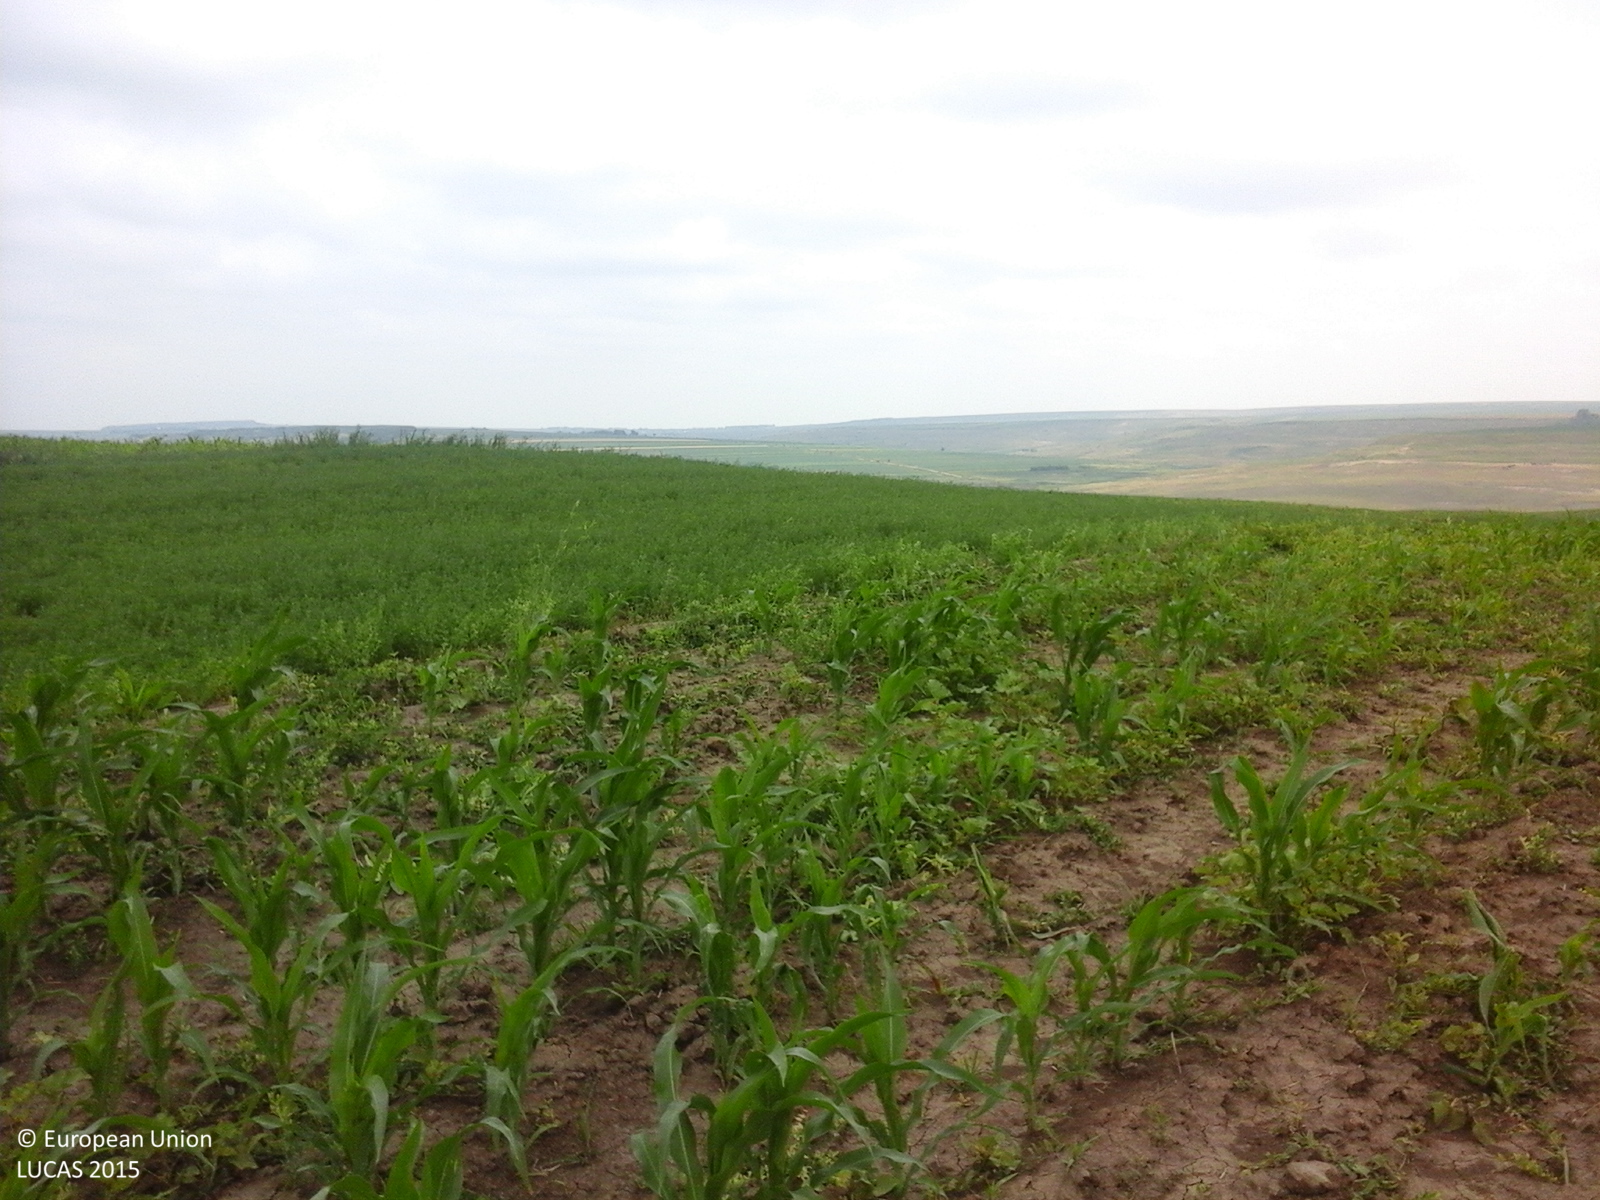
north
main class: Cropland
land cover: Maize
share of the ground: 25 - 50 %
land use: Agriculture (excluding fallow land and kitchen gardens)
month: June
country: RO
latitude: 47.8104
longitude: 26.6403
